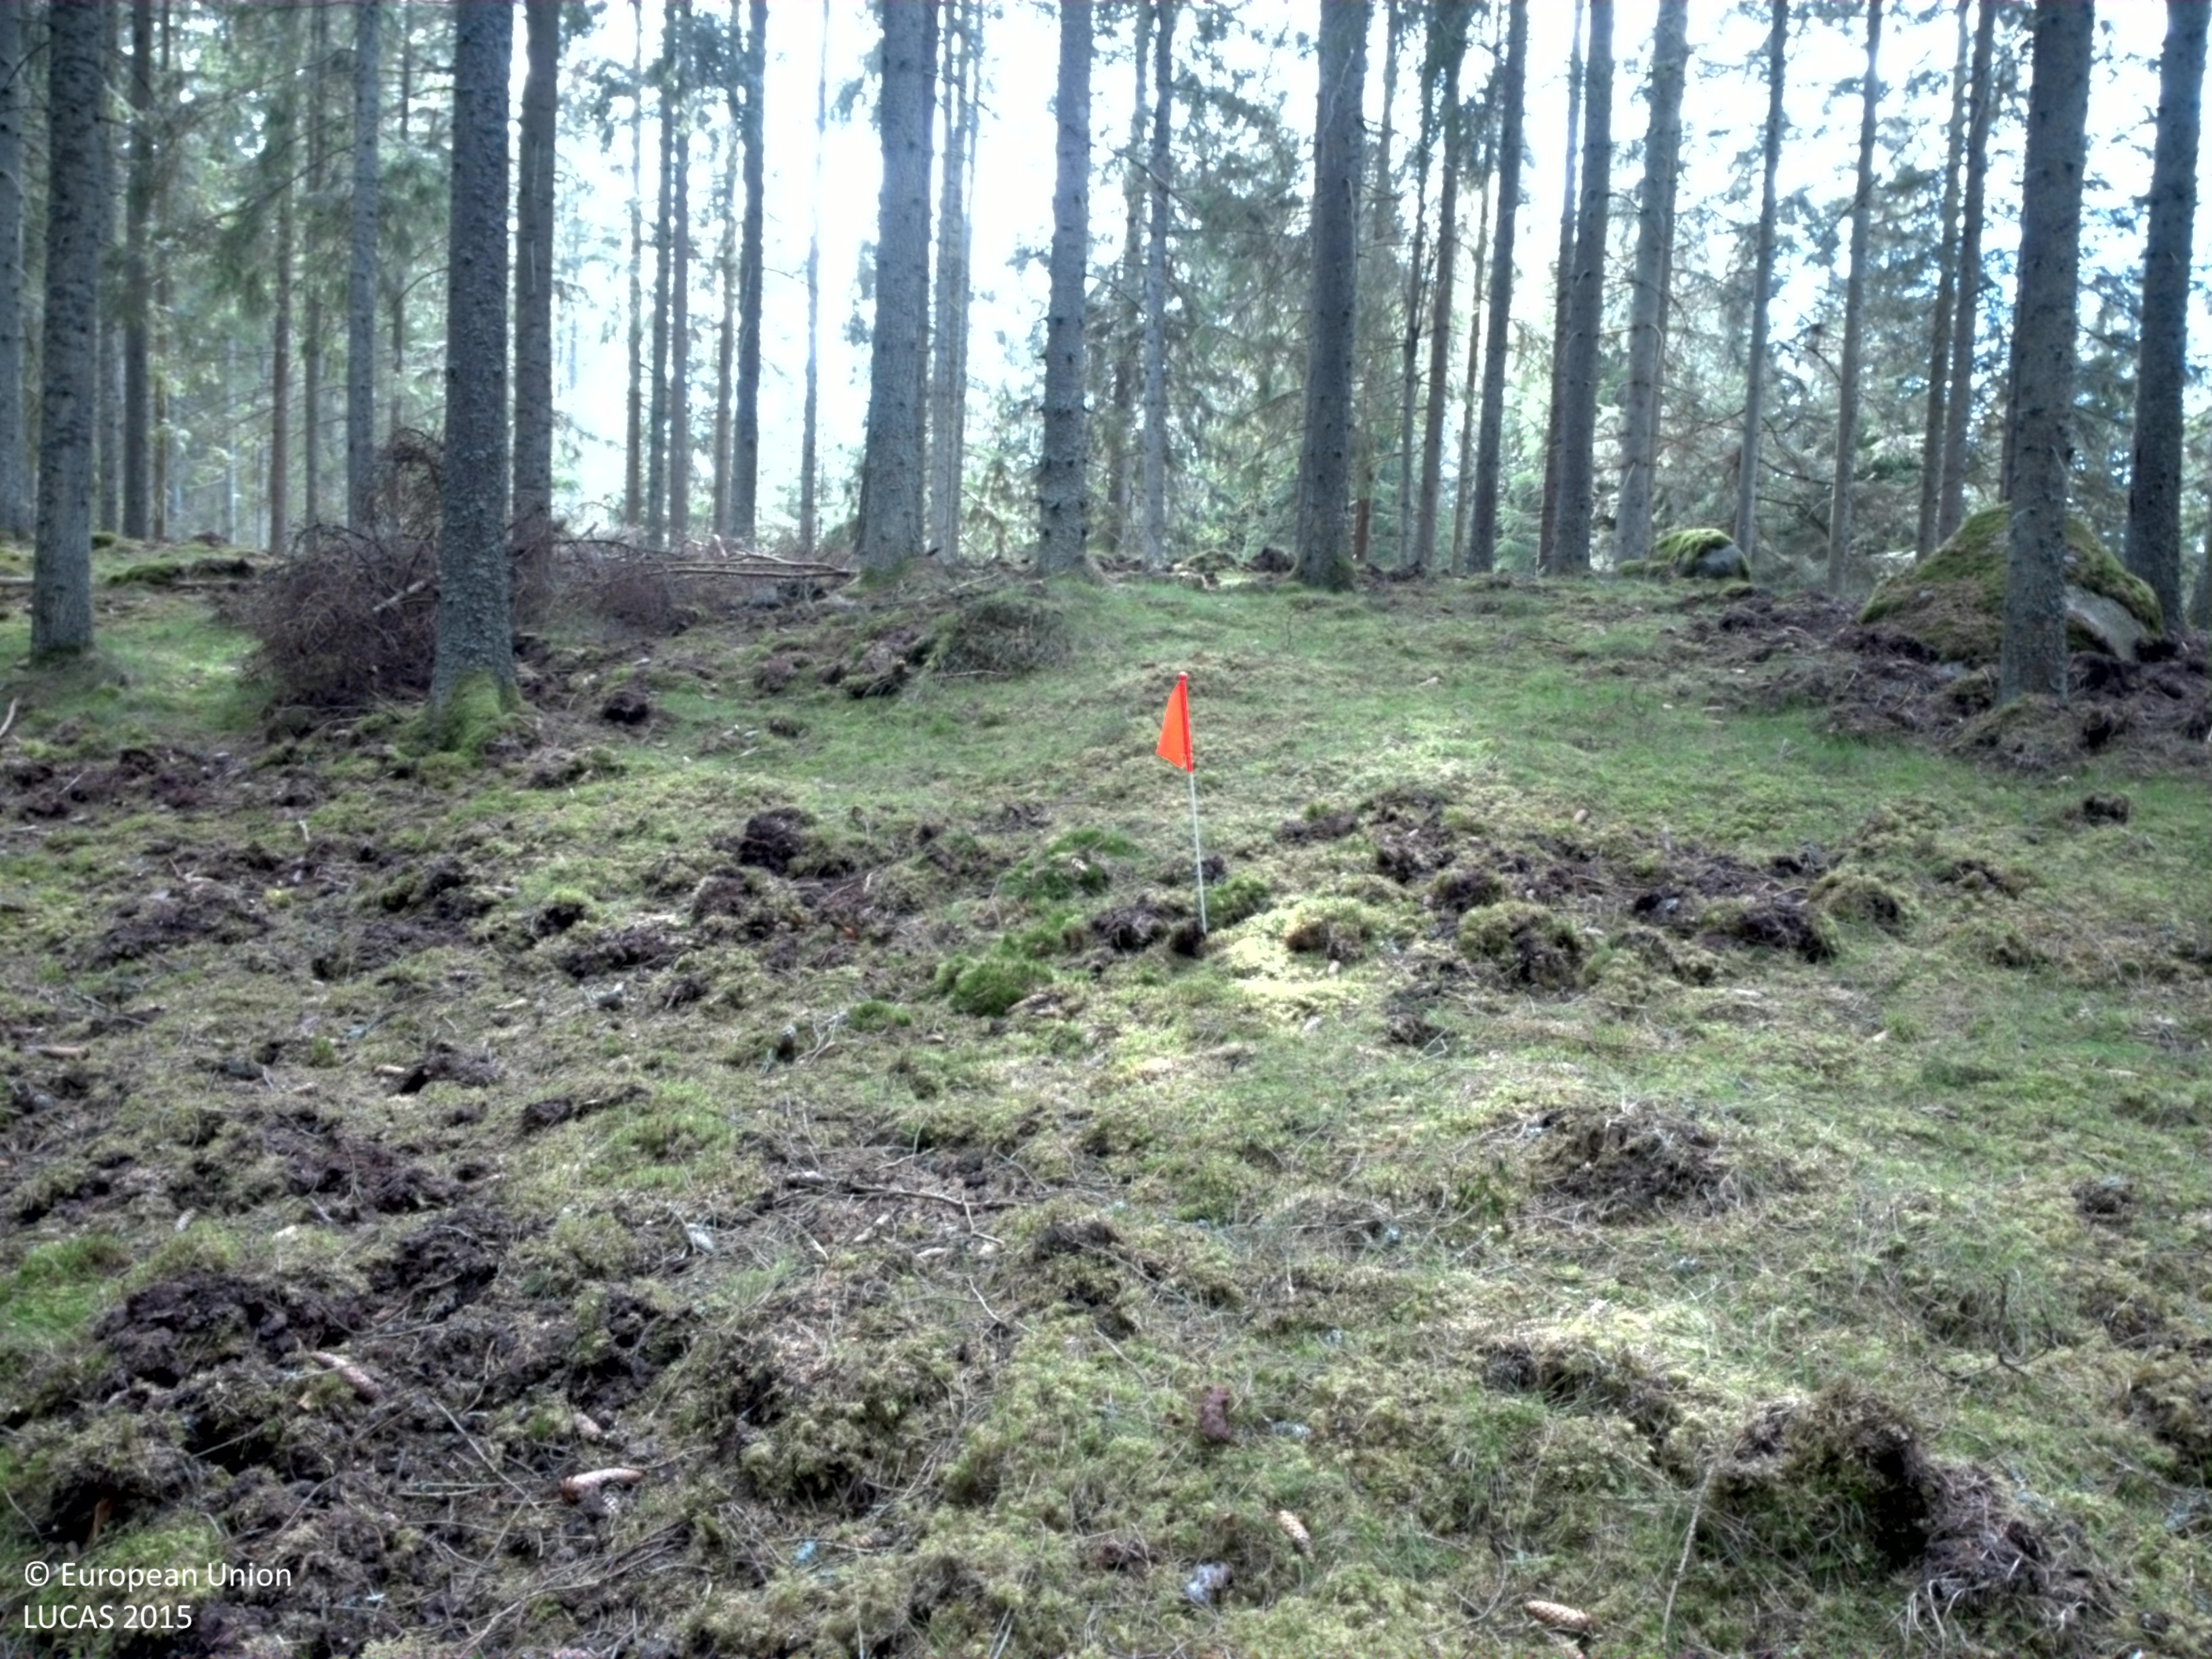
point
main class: Woodland
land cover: Spruce dominated coniferous woodland
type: boreal forest
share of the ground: > 75 %
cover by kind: coniferous forest trees 90 %, lichens and mosses 10 %
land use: Forestry
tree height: > 5 m
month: May
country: SE
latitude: 56.4343
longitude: 15.8219
